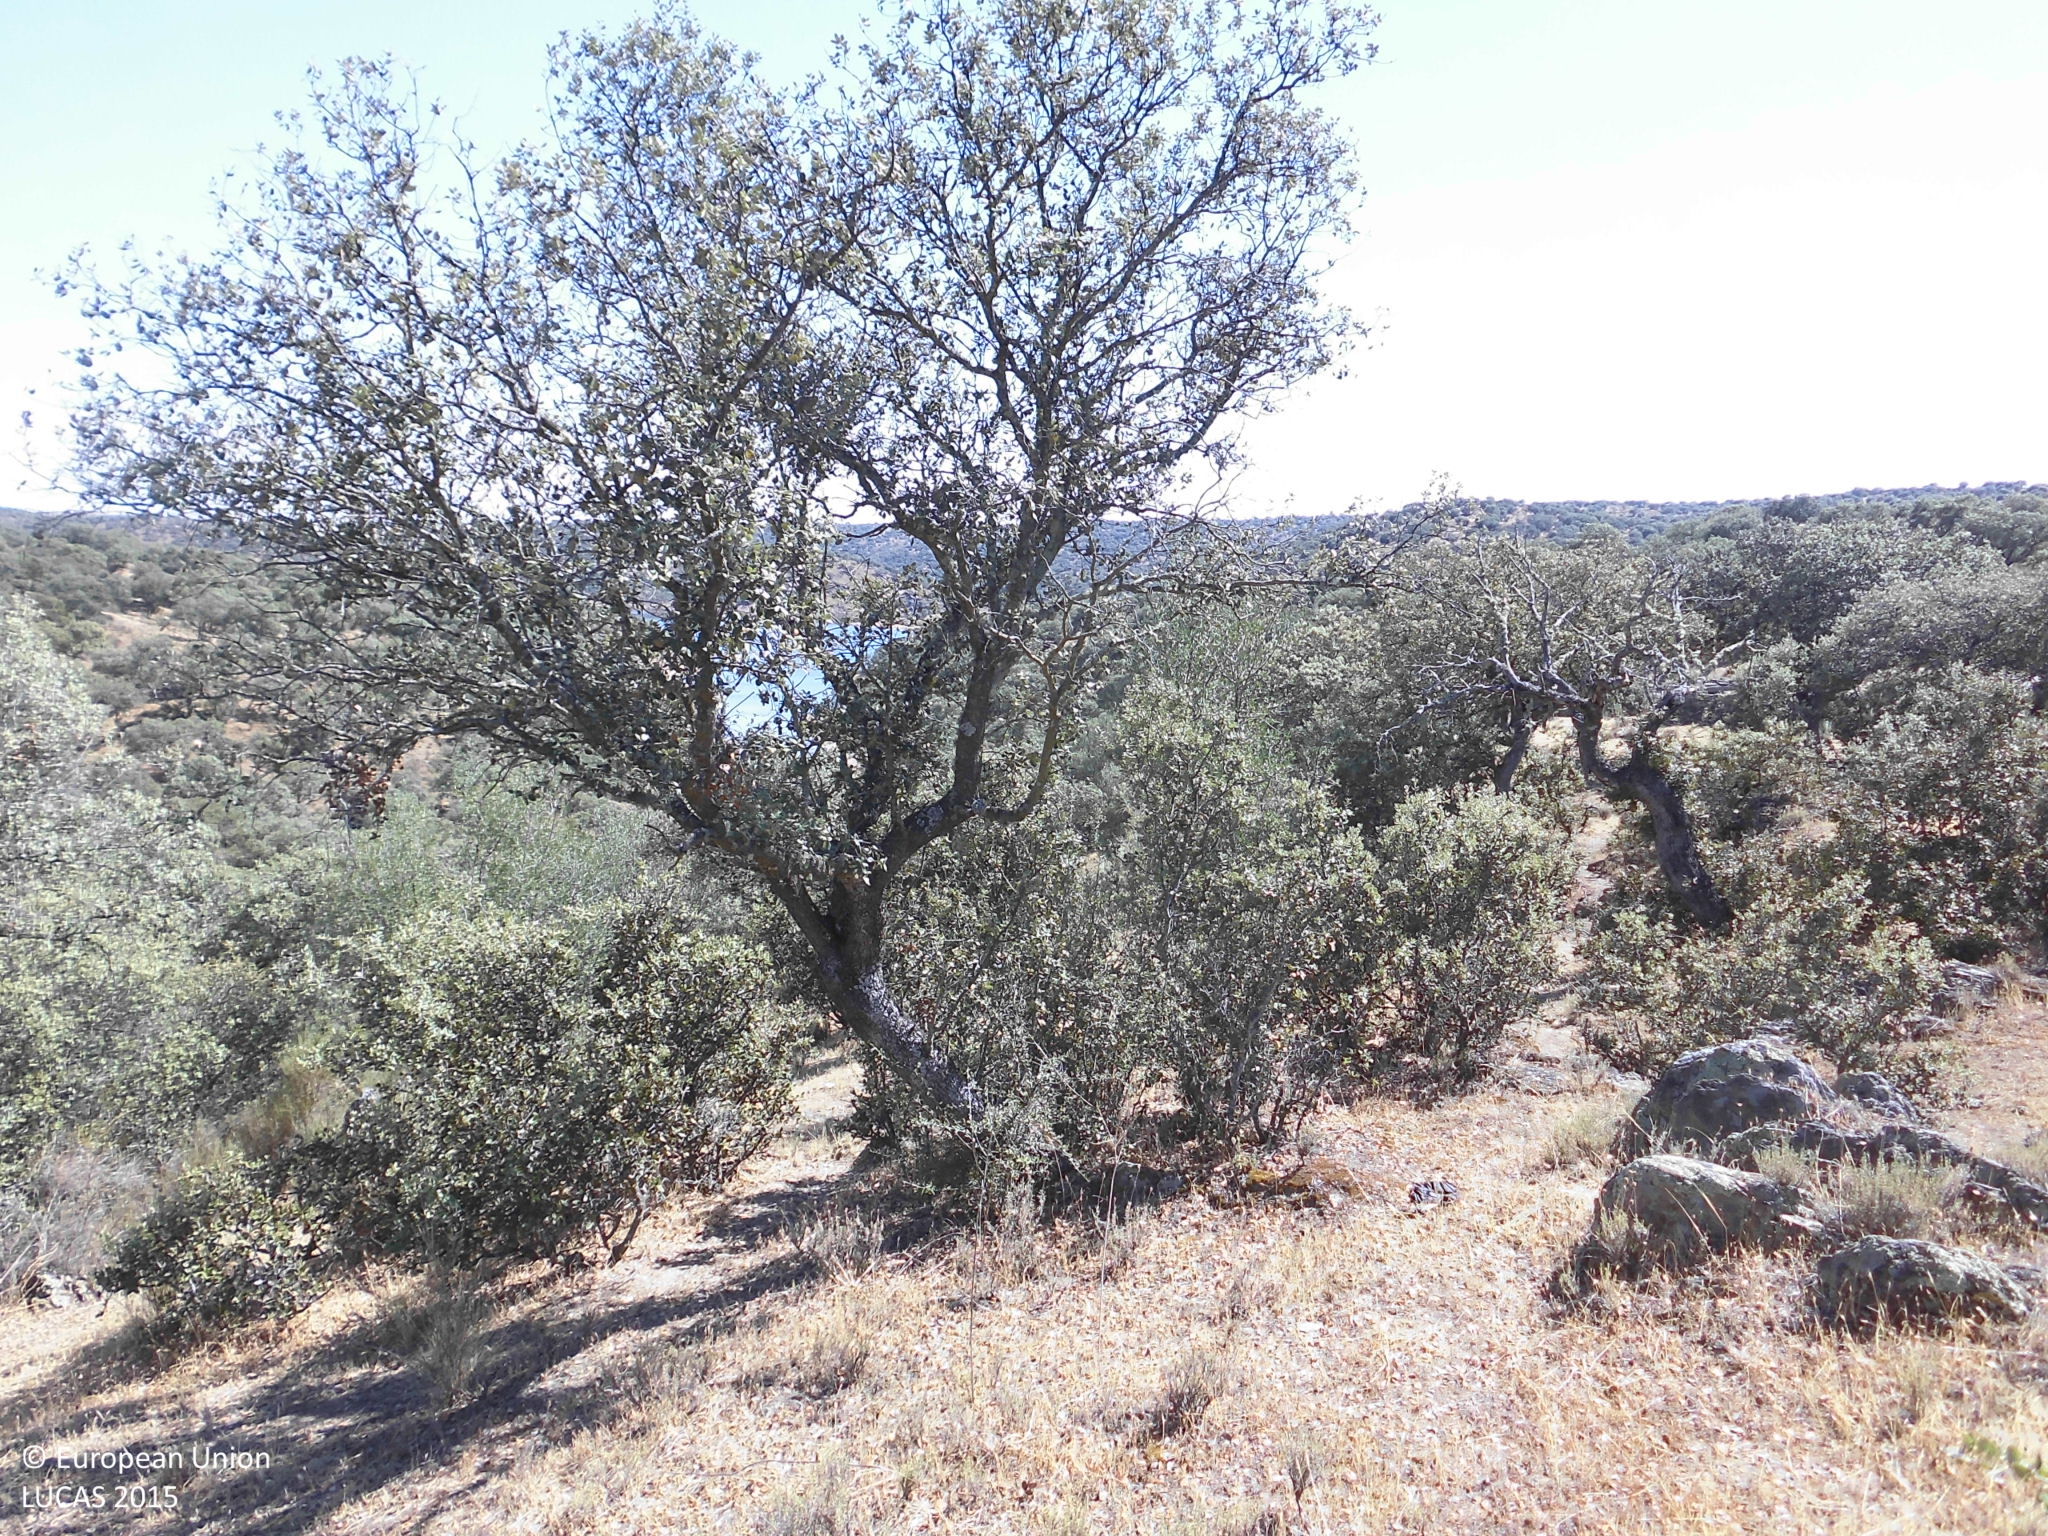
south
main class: Woodland
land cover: Broadleaved woodland
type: broadleaved evergreen forest
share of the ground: 10 - 25 %
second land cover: Shrubland without tree cover
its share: 25 - 50 %
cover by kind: herbaceous plants 45 %, broadleaved forest trees 25 %, shrubs 25 %, consolidated bare surface 5 %
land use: Forestry
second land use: Agriculture (excluding fallow land and kitchen gardens)
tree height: > 5 m
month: June
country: ES
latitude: 39.6289
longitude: -6.4171
